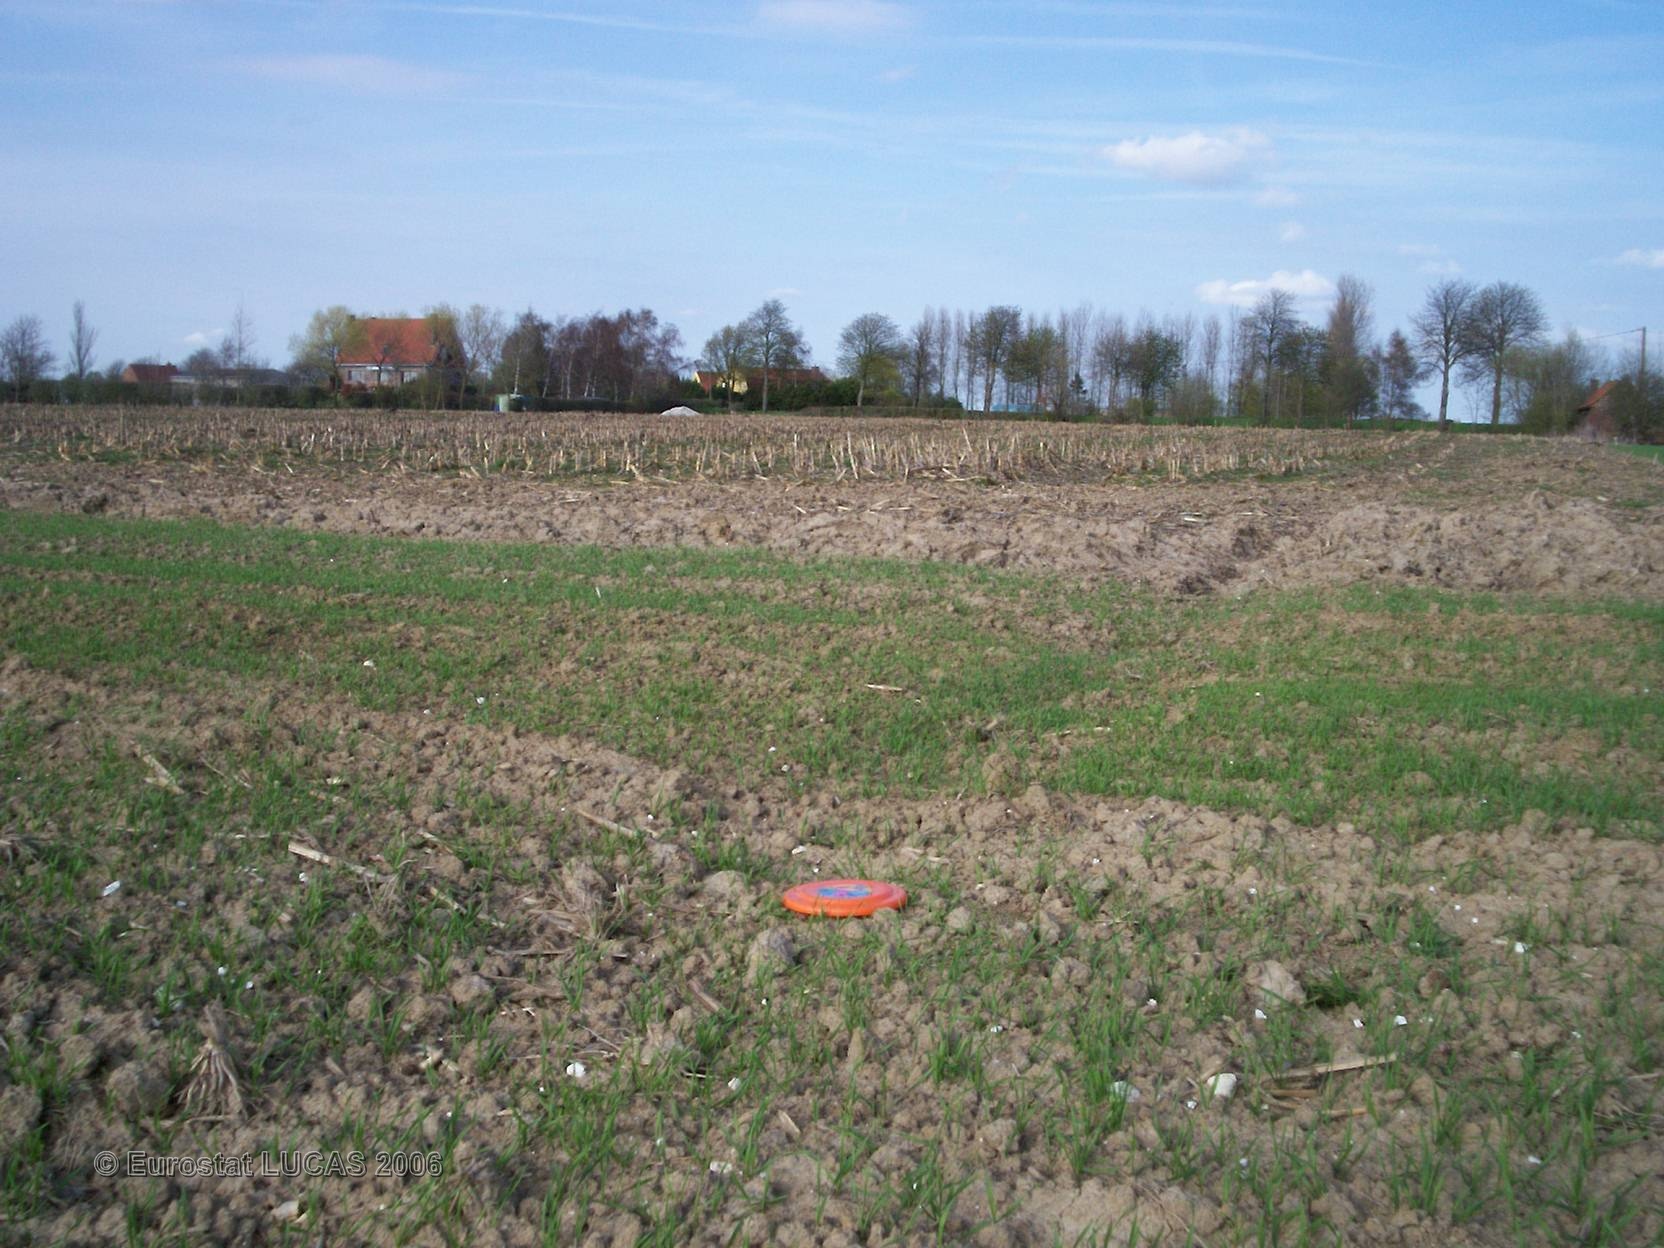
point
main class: Cropland
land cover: Common wheat
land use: Agriculture (excluding fallow land and kitchen gardens)
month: April
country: FR
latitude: 50.8384
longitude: 2.4751
